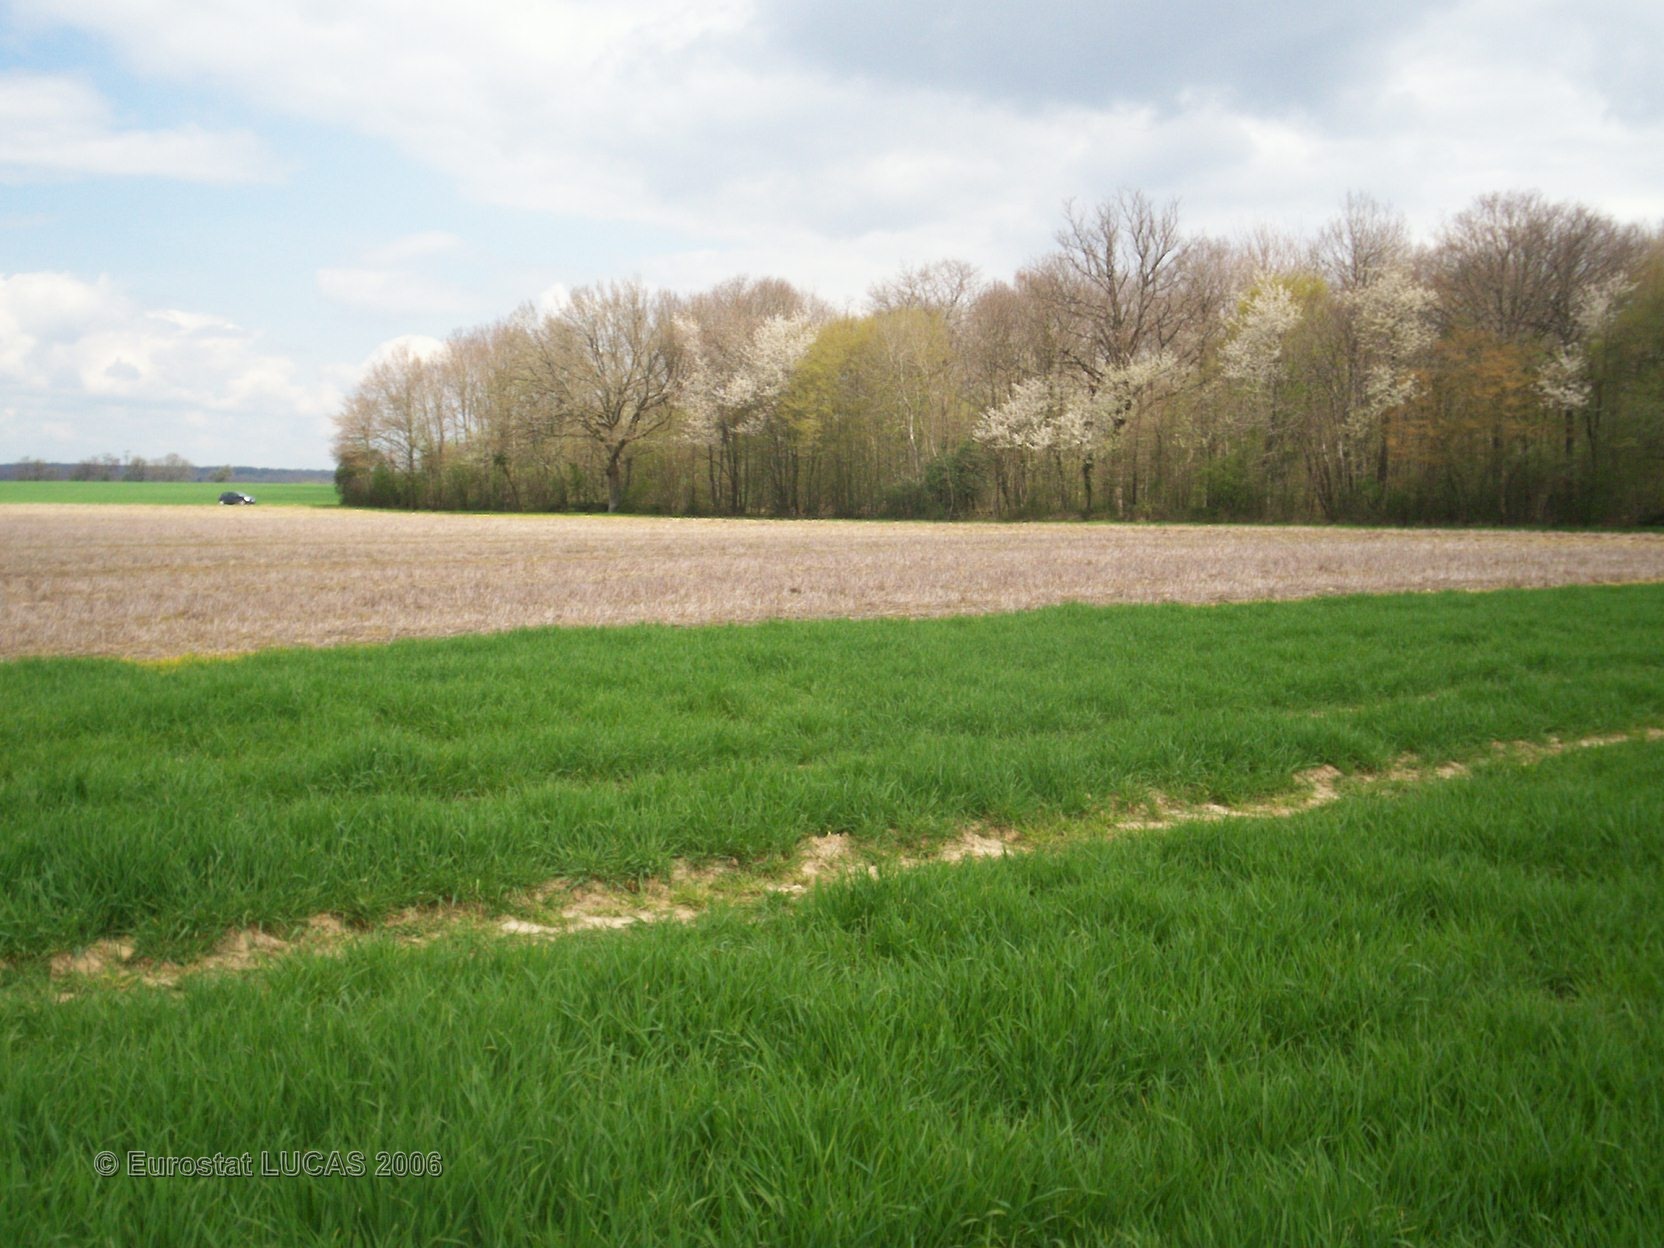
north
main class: Cropland
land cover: Barley
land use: Agriculture (excluding fallow land and kitchen gardens)
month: April
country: FR
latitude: 47.6286
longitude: 0.8922
